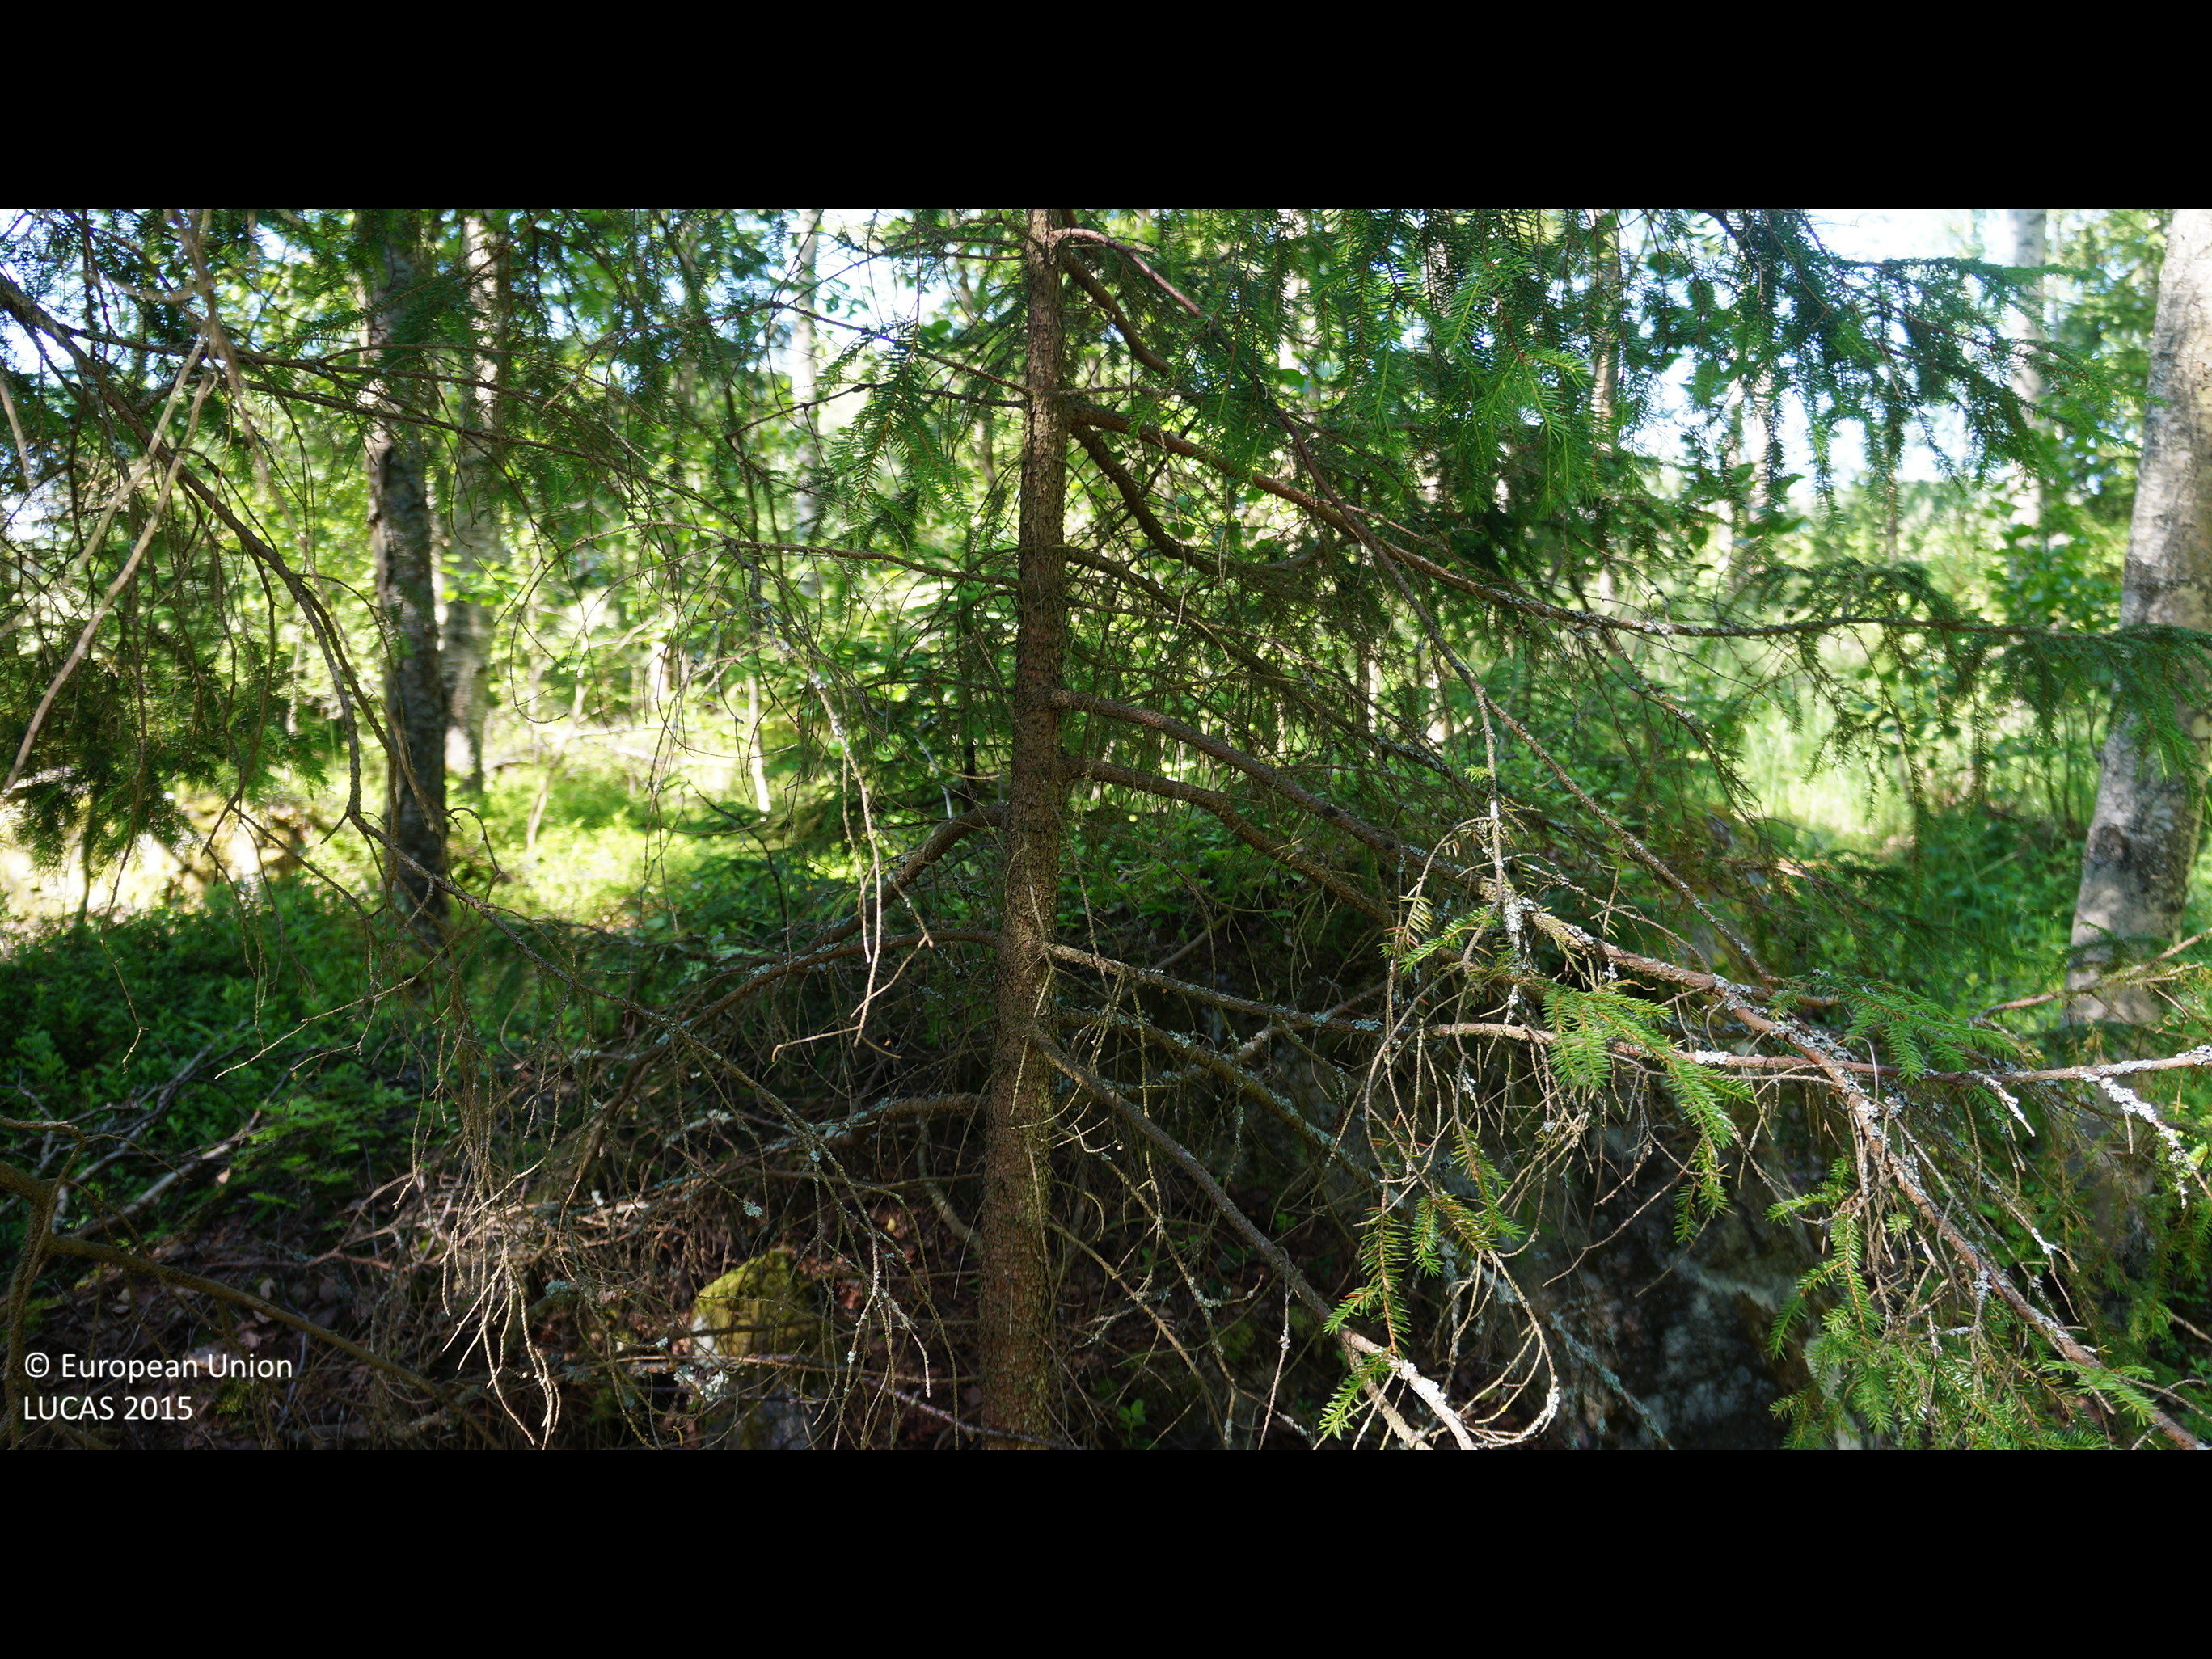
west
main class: Woodland
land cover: Spruce dominated mixed woodland
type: boreal forest
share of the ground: 50 - 75 %
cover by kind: coniferous forest trees 40 %, shrubs 25 %, broadleaved forest trees 20 %, herbaceous plants 15 %
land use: Forestry
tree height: > 5 m
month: July
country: FI
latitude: 63.7959
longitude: 22.8986
